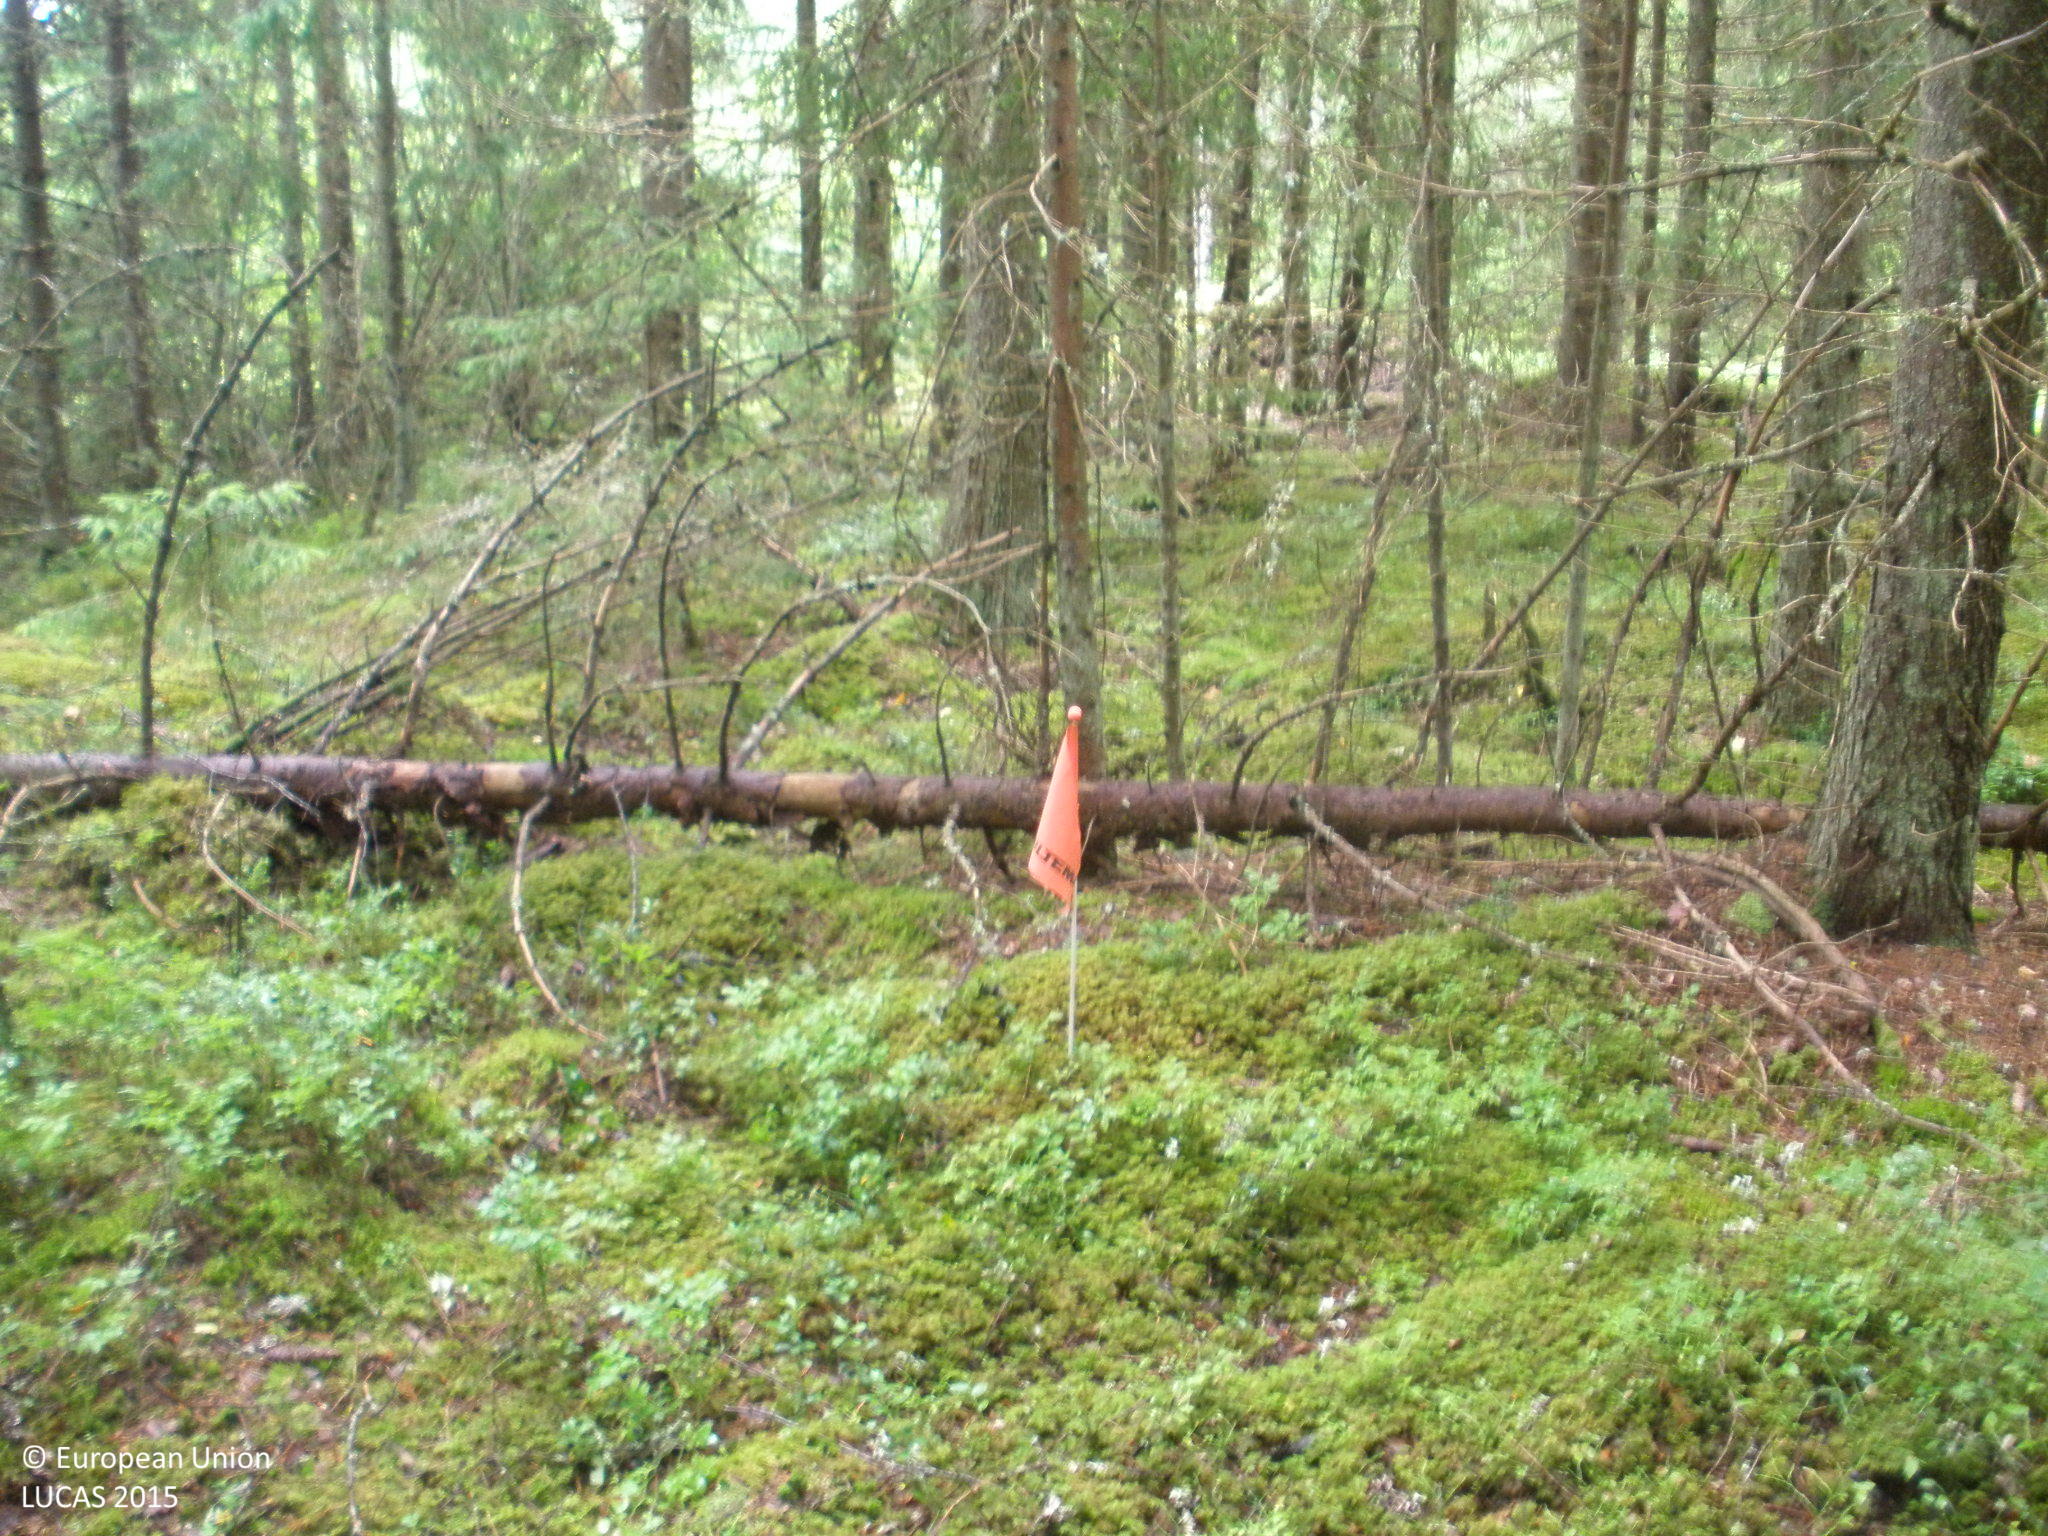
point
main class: Woodland
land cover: Spruce dominated coniferous woodland
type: boreal forest
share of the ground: > 75 %
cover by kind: coniferous forest trees 95 %, lichens and mosses 5 %
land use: Forestry
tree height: > 5 m
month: July
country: FI
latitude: 60.6732
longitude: 23.3899
